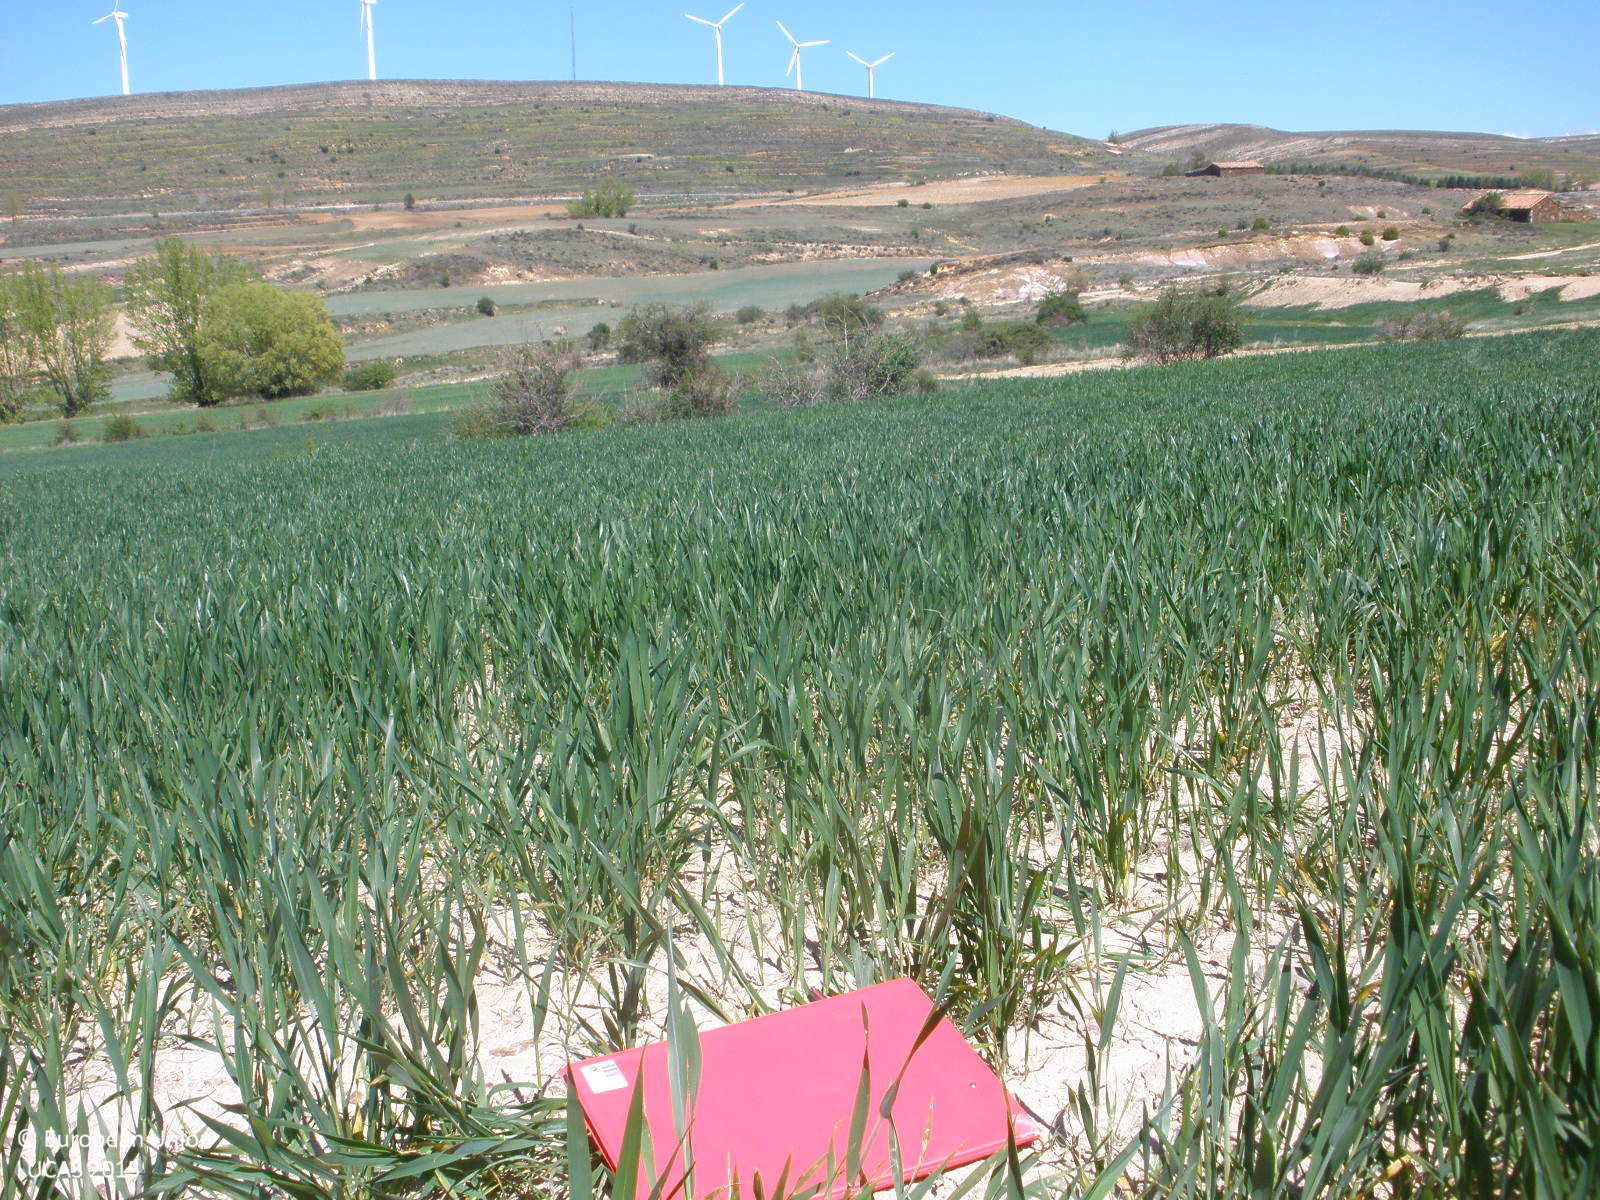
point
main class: Cropland
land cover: Durum wheat
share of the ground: 50 - 75 %
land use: Agriculture (excluding fallow land and kitchen gardens)
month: May
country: ES
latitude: 40.7577
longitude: -0.8514
